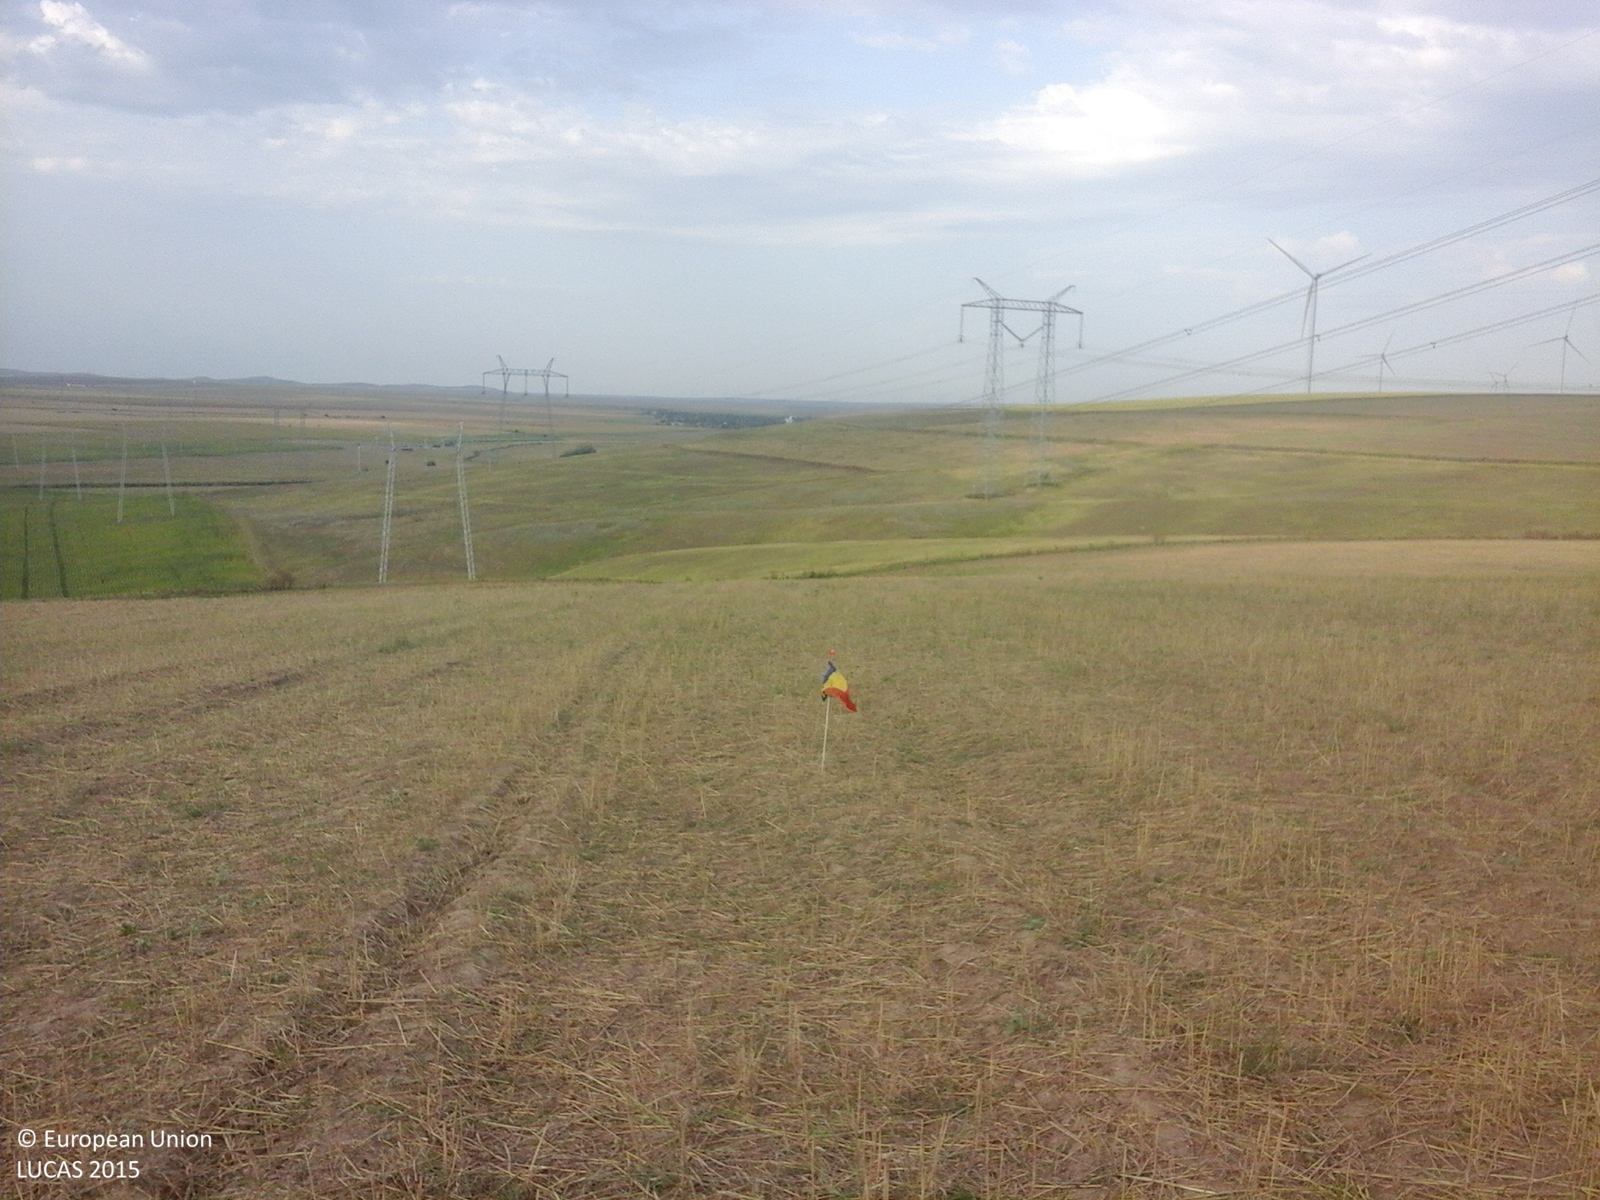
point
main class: Cropland
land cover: Common wheat
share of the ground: 25 - 50 %
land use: Agriculture (excluding fallow land and kitchen gardens)
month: August
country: RO
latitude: 44.3763
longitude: 28.1458
